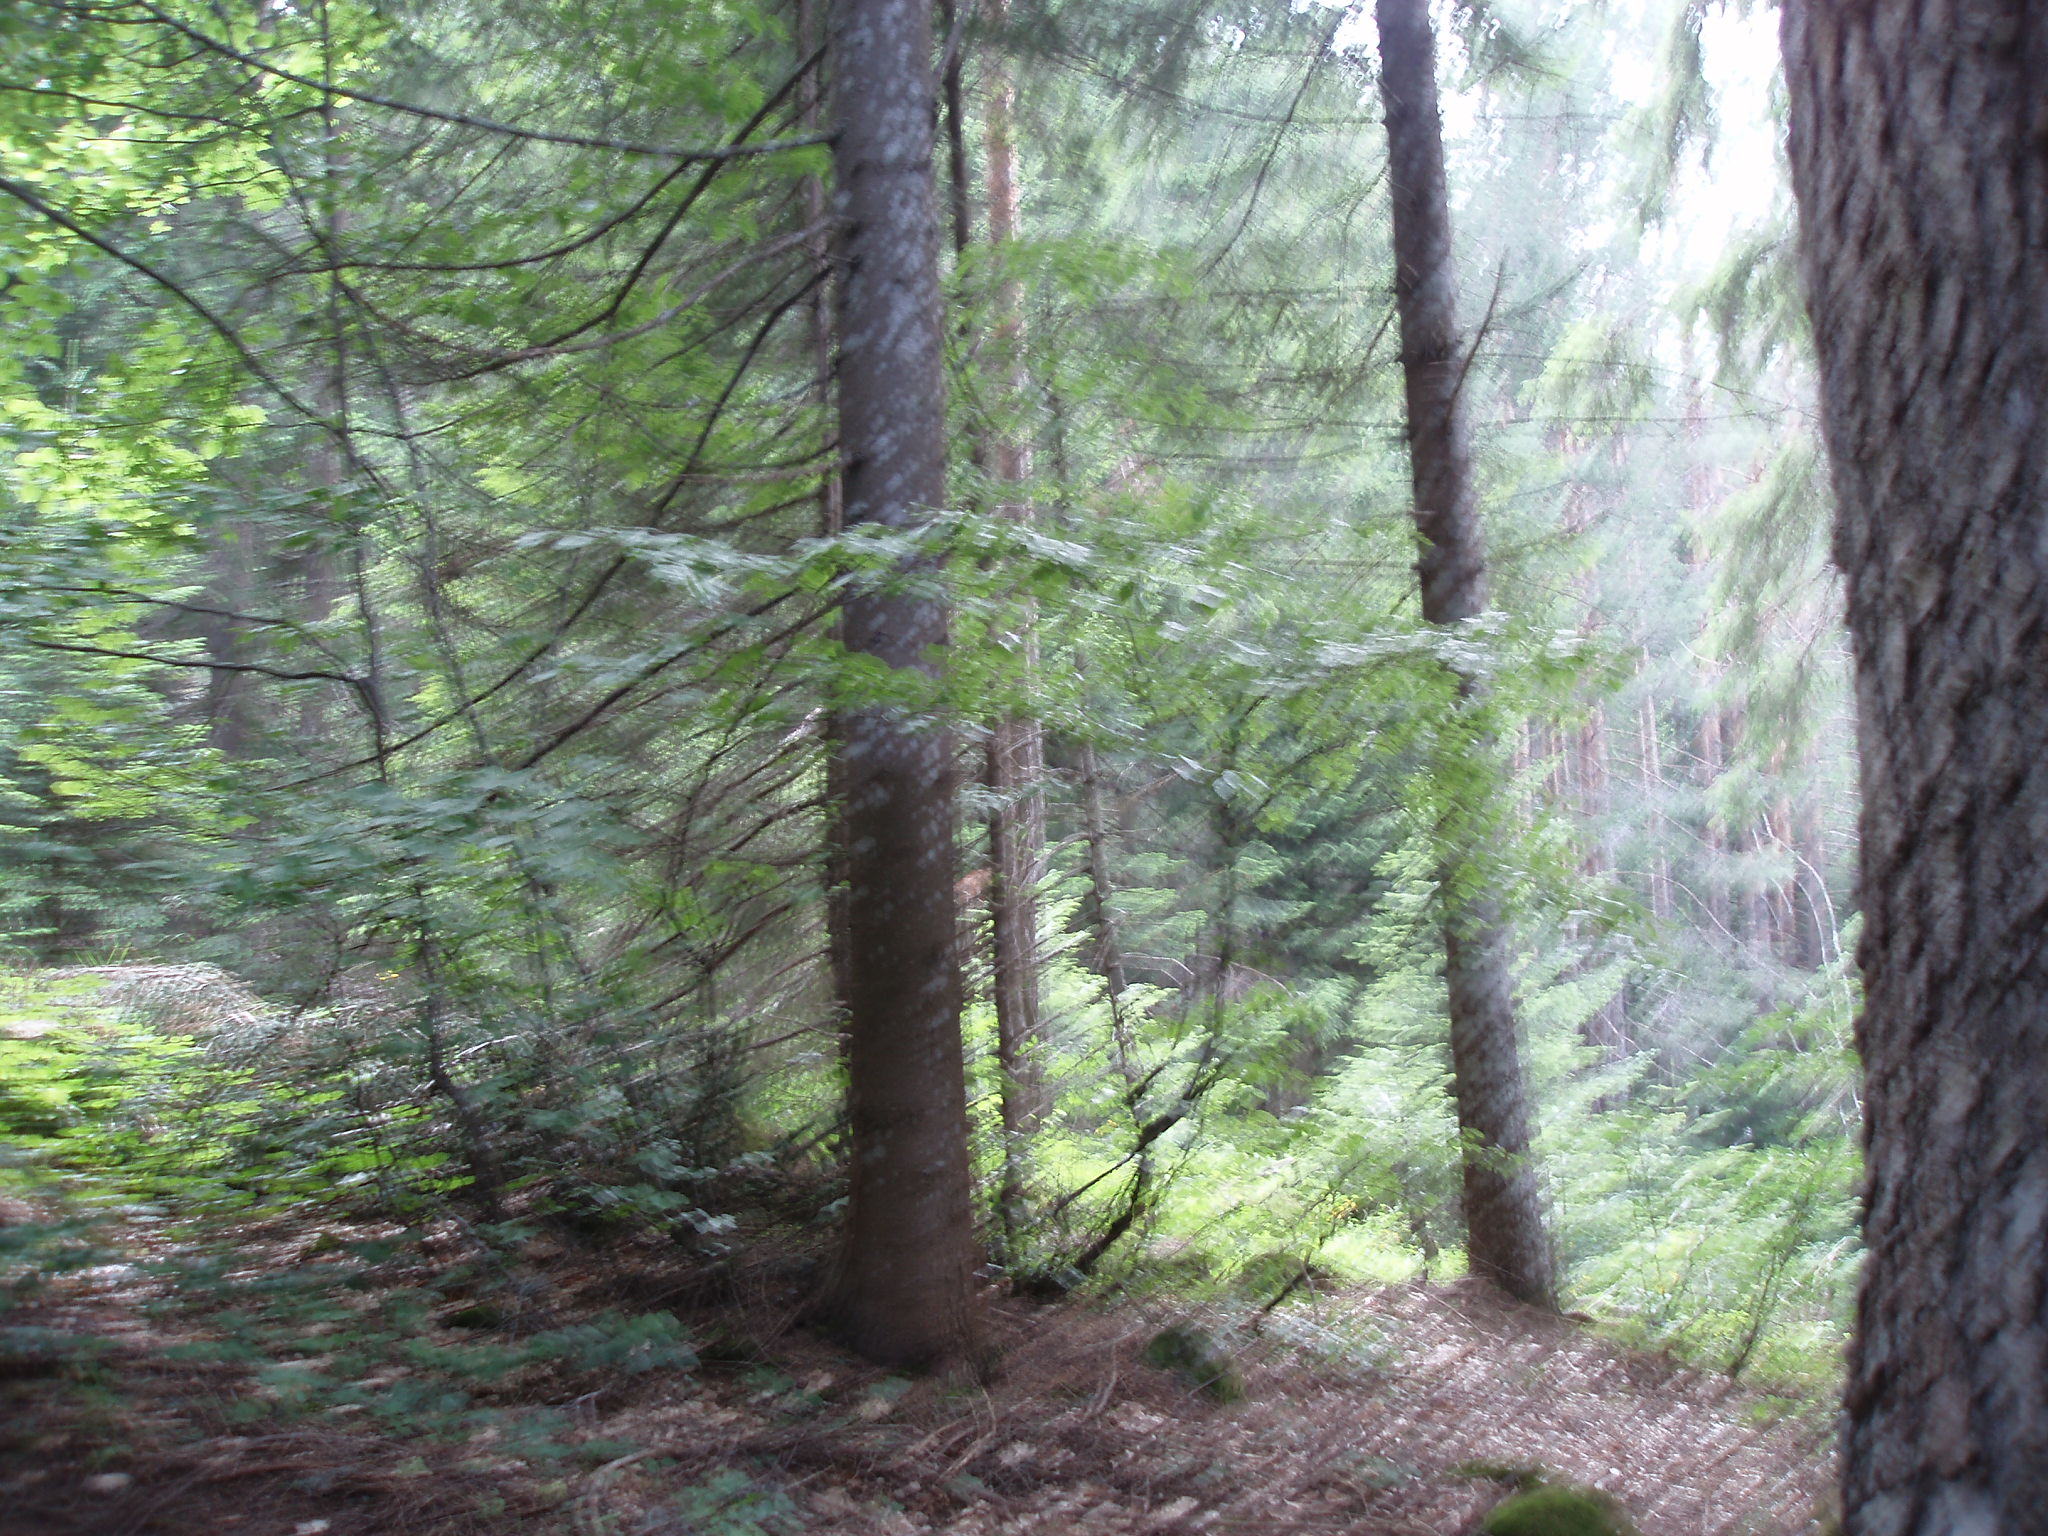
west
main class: Woodland
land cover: Spruce dominated mixed woodland
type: hemiboreal forest and nemoral coniferous forest and mixed broadleaved-coniferous forest
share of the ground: > 75 %
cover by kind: coniferous forest trees 75 %, broadleaved forest trees 25 %
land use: Amenities, museums, leisure
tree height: > 5 m
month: July
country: BG
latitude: 41.8043
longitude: 23.4713
